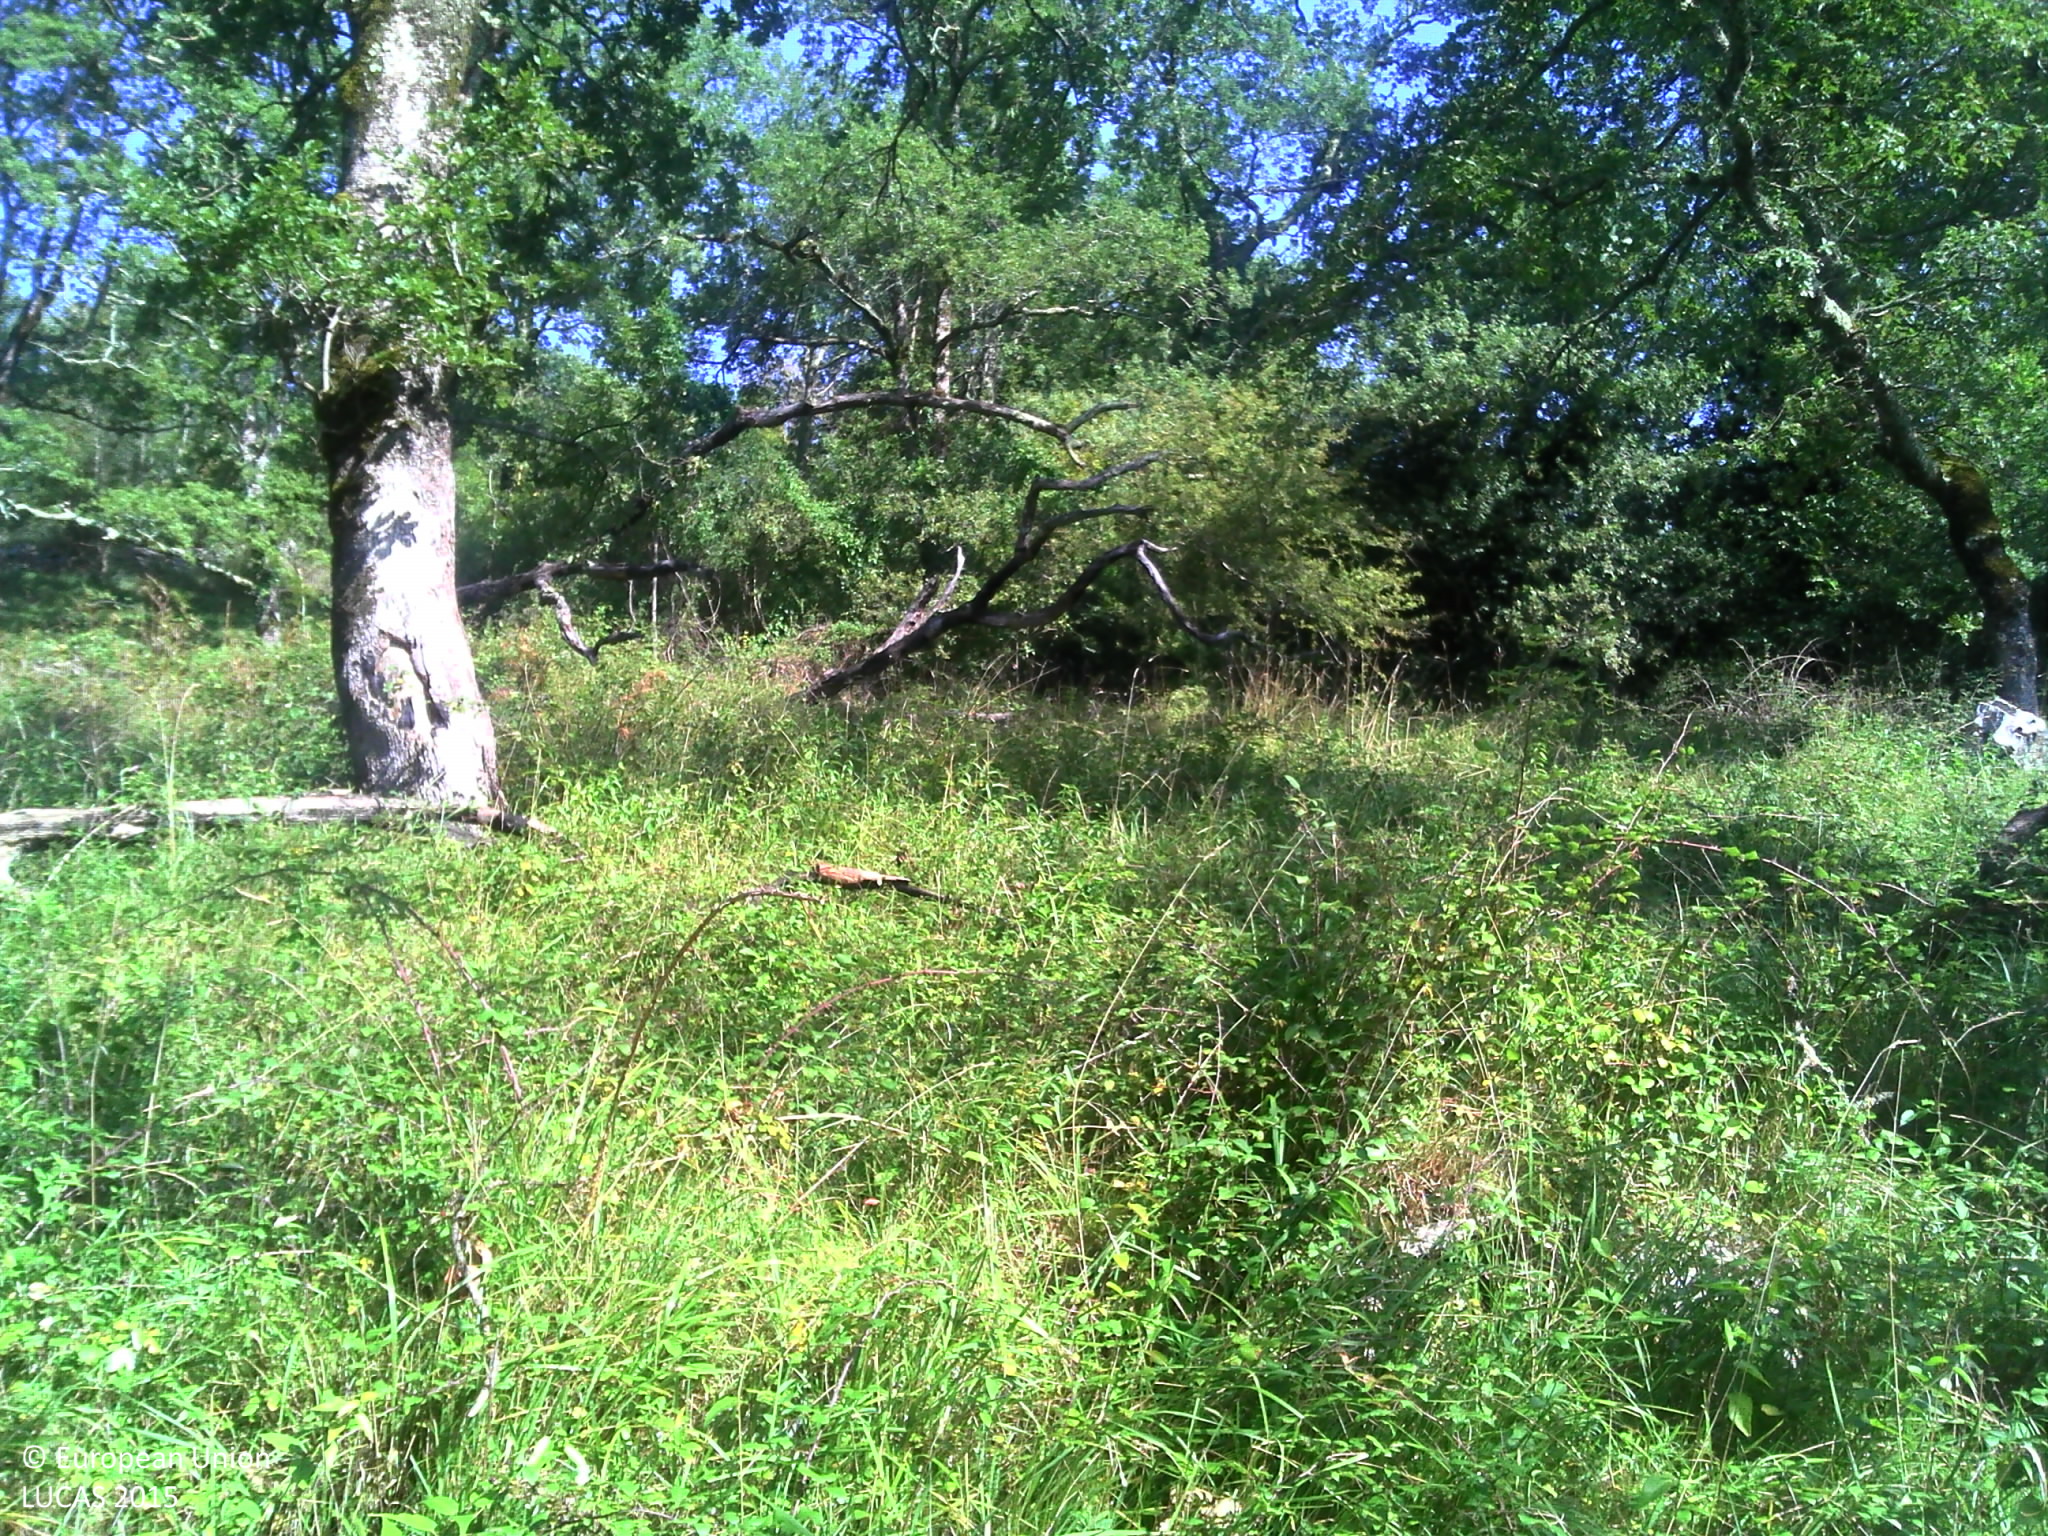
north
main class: Woodland
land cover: Broadleaved woodland
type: acidophilous oak and oak-birch forest
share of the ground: 25 - 50 %
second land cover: Grassland without tree/shrub cover
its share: 50 - 75 %
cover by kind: broadleaved forest trees 40 %, herbaceous plants 40 %, shrubs 15 %, consolidated bare surface 5 %
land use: Forestry
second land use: Agriculture (excluding fallow land and kitchen gardens)
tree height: > 5 m
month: September
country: FR
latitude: 43.0980
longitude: -0.9325
